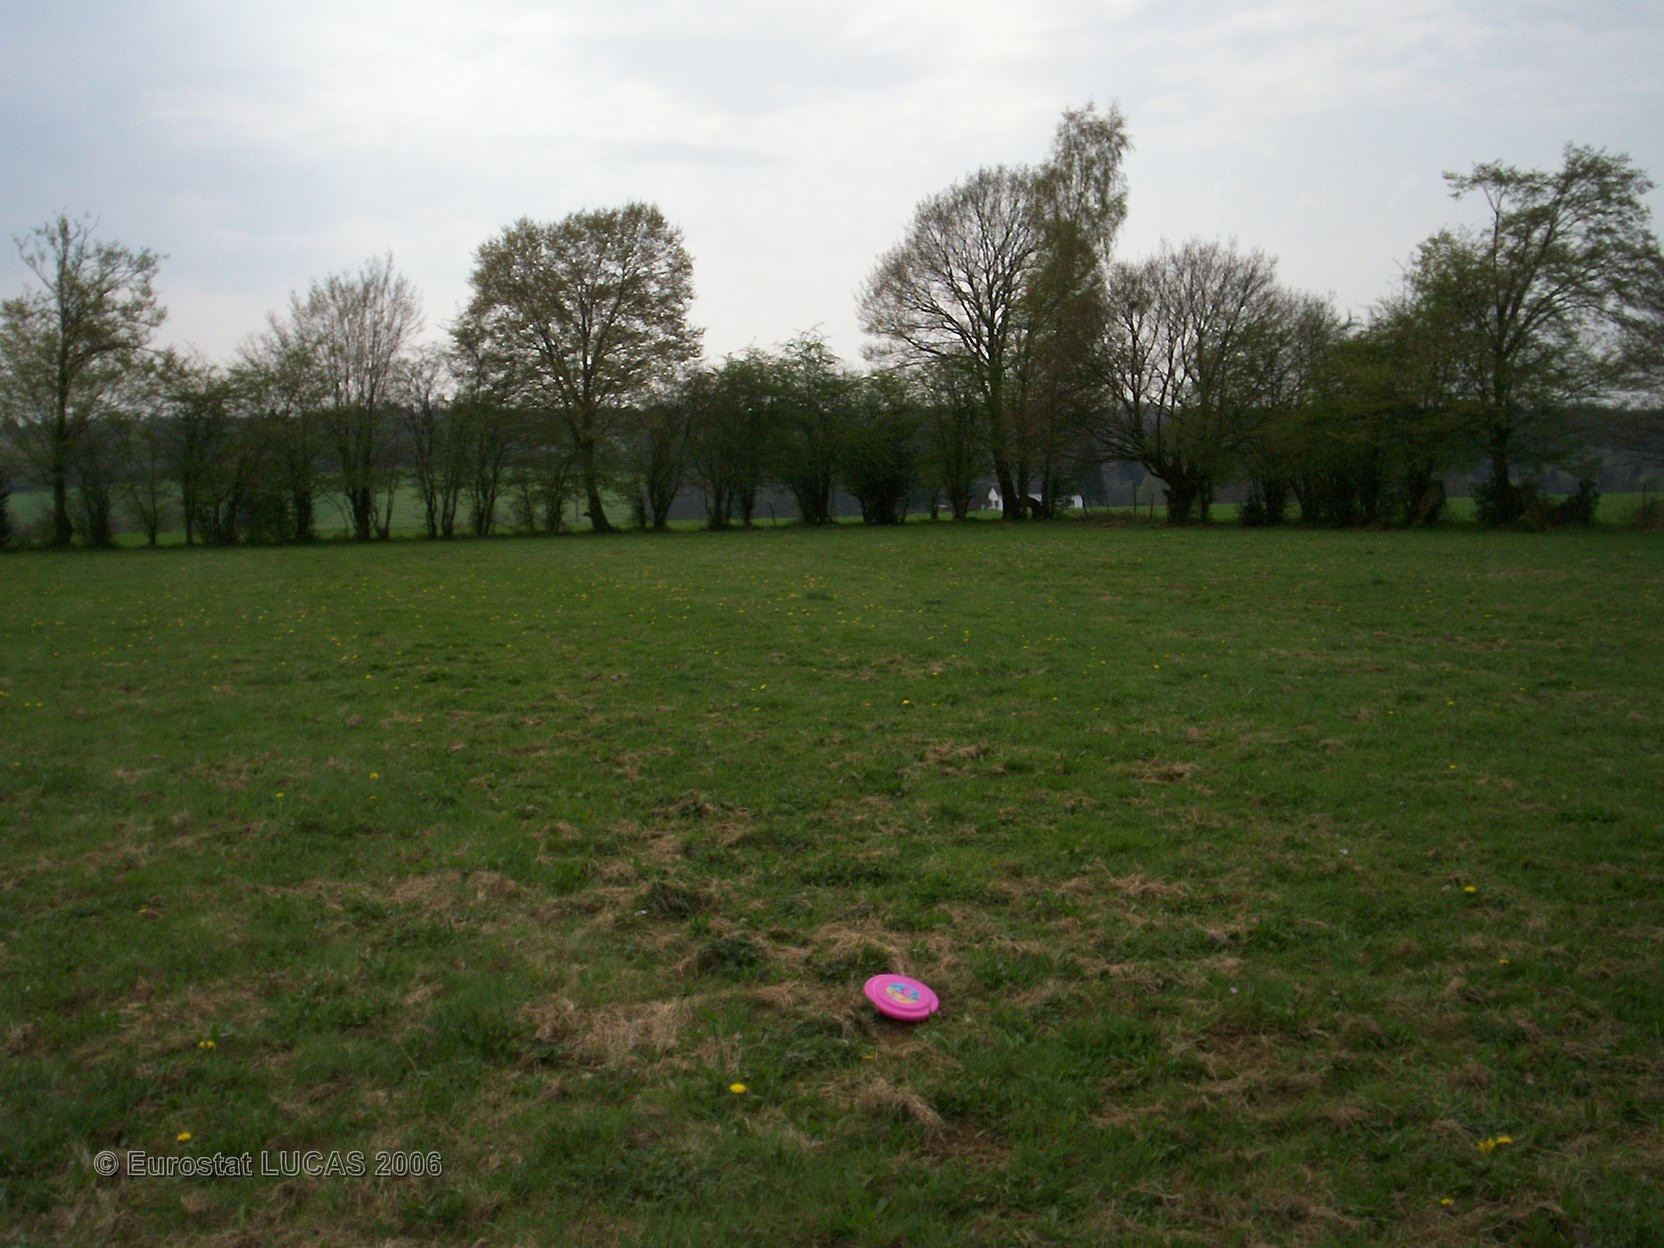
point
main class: Grassland
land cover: Grassland without tree/shrub cover
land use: Agriculture (excluding fallow land and kitchen gardens)
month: May
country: FR
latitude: 49.9334
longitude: 4.2973
